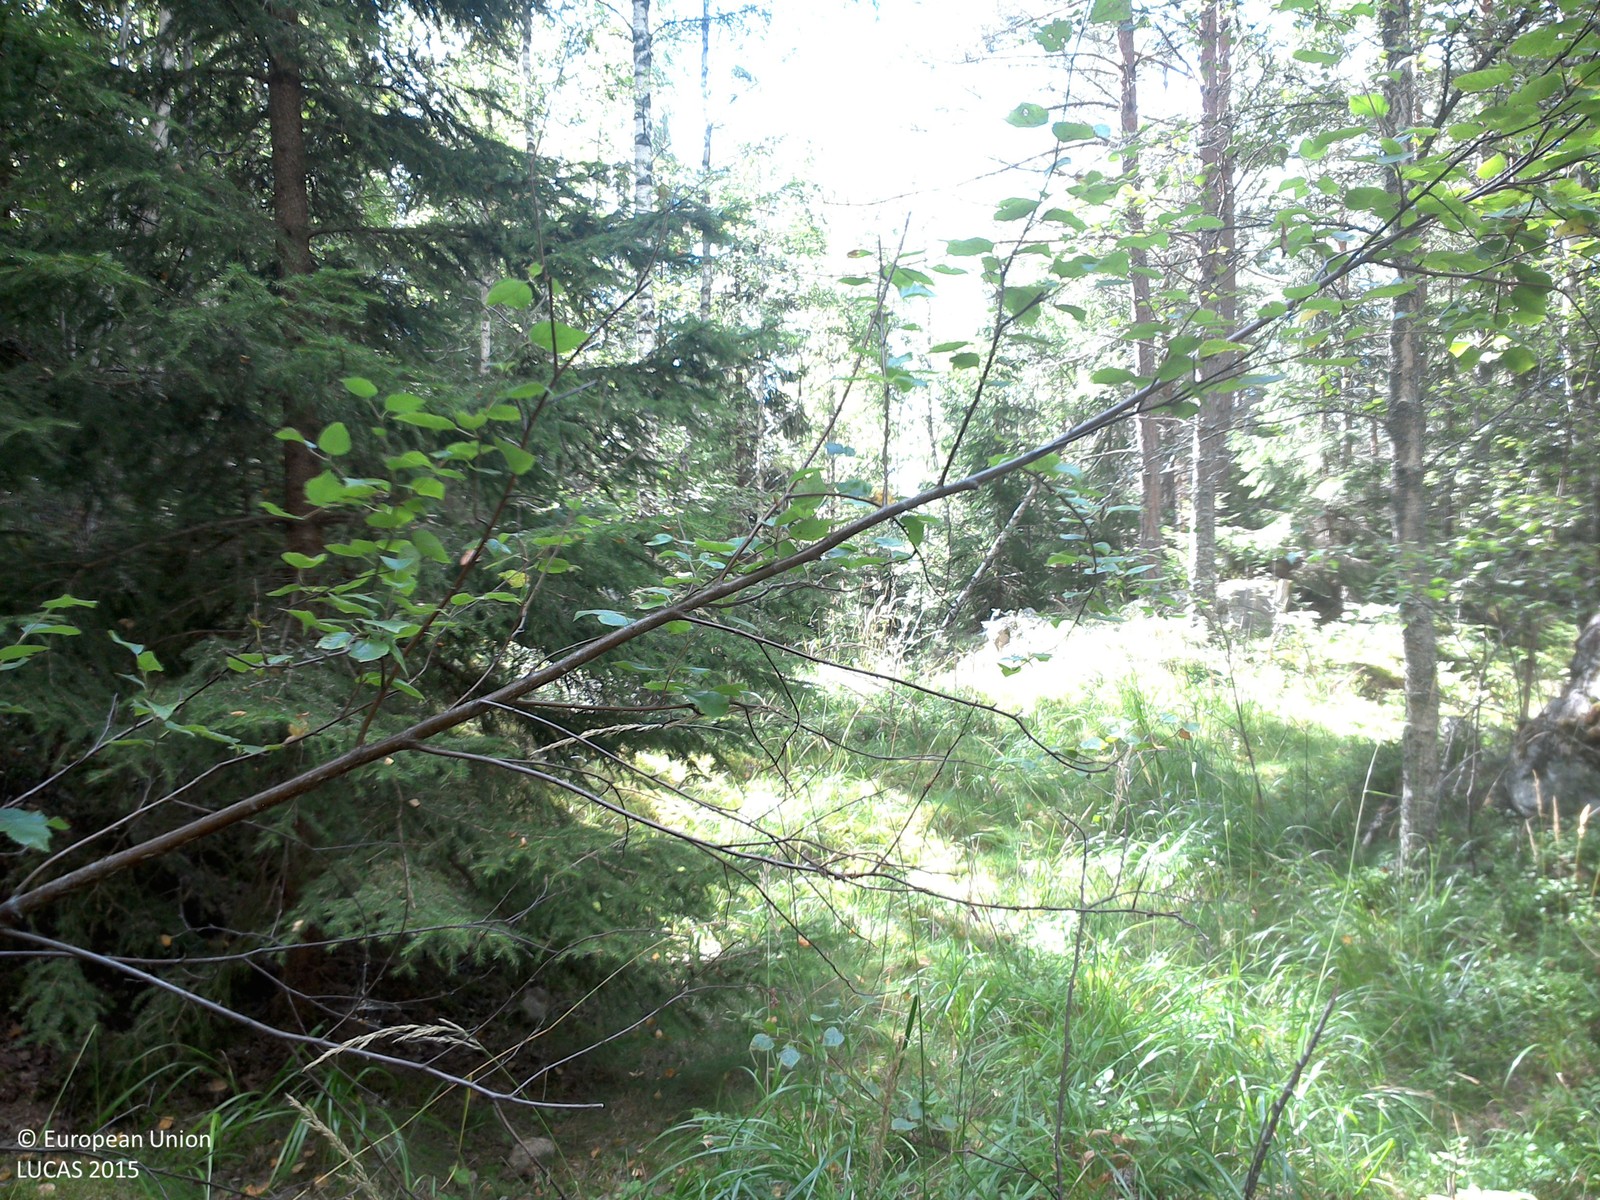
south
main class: Woodland
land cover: Spruce dominated mixed woodland
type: boreal forest
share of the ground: > 75 %
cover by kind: coniferous forest trees 45 %, herbaceous plants 25 %, broadleaved forest trees 20 %, shrubs 5 %, lichens and mosses 5 %
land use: Forestry
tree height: > 5 m
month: August
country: SE
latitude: 58.0789
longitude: 15.3025
